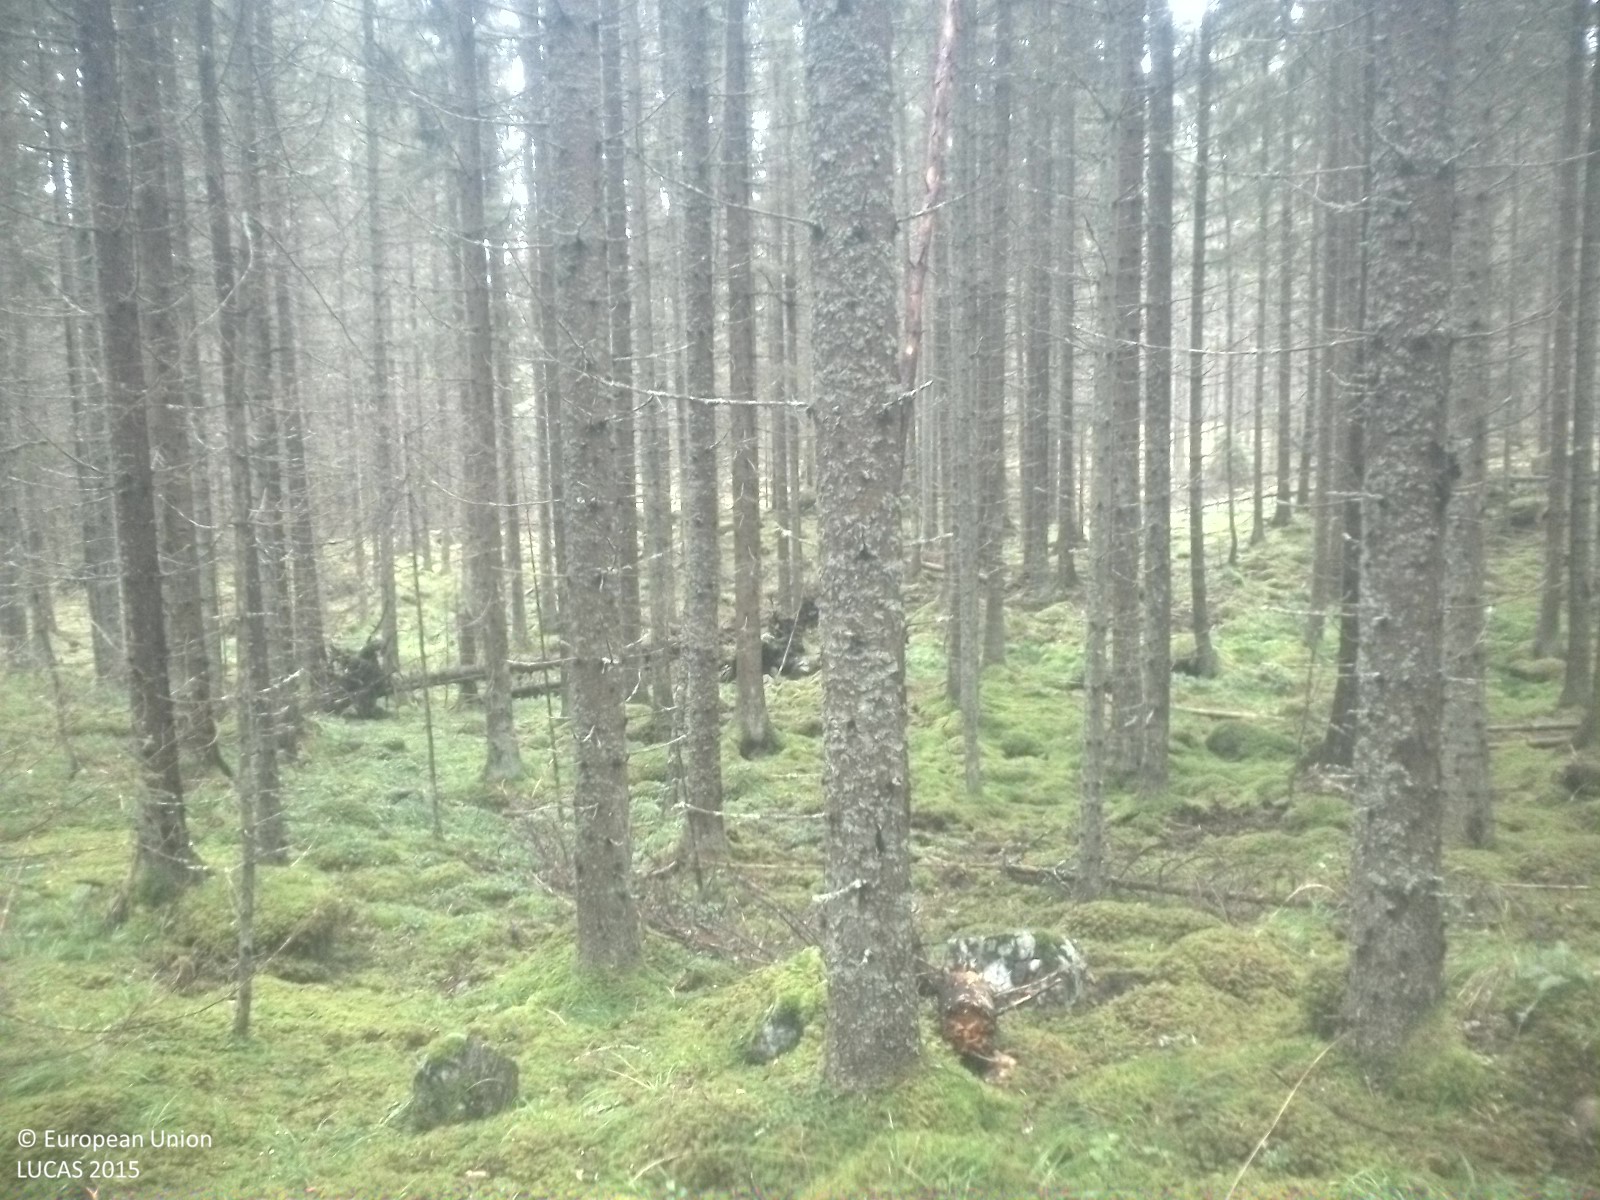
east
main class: Woodland
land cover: Spruce dominated coniferous woodland
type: boreal forest
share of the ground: 50 - 75 %
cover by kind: coniferous forest trees 55 %, lichens and mosses 40 %, herbaceous plants 5 %
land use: Forestry
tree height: > 5 m
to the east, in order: Spruce dominated coniferous woodland
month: September
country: SE
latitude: 58.8357
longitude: 15.7627
